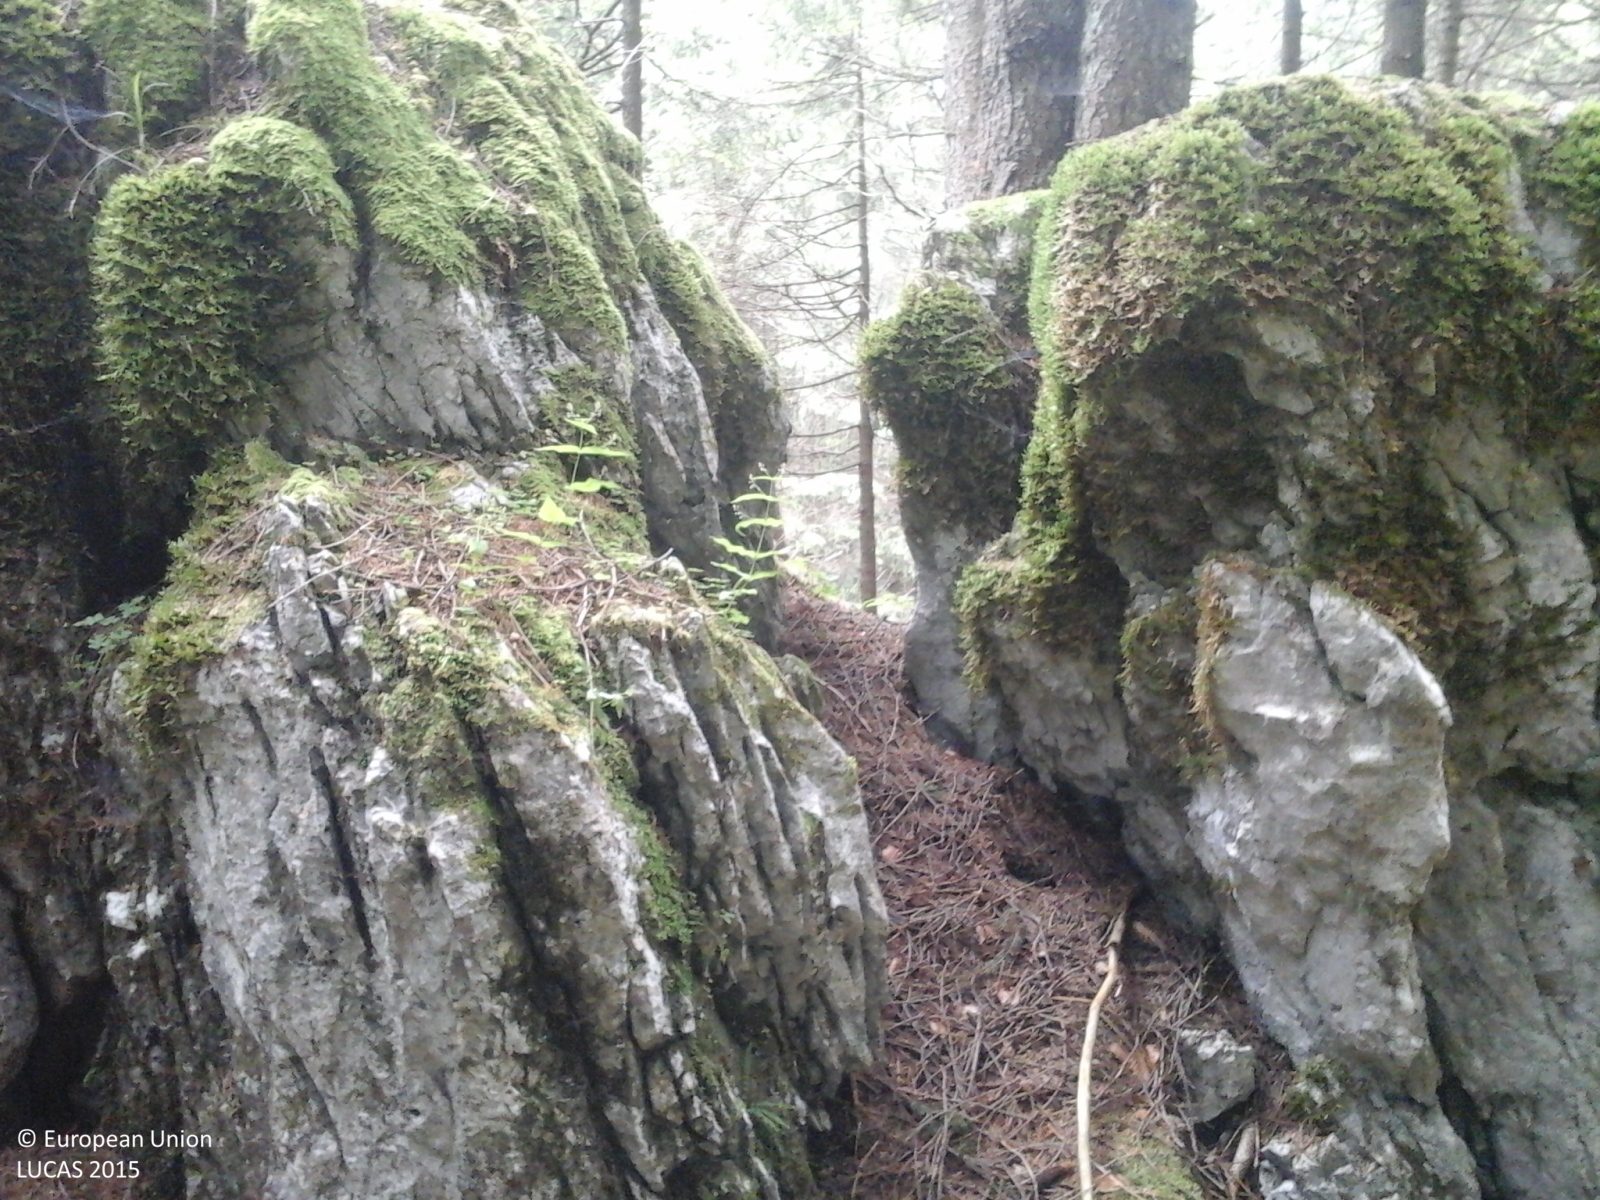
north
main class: Woodland
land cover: Spruce dominated mixed woodland
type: alpine coniferous forest
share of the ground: > 75 %
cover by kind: coniferous forest trees 75 %, broadleaved forest trees 25 %
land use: Forestry
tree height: > 5 m
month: June
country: IT
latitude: 45.8177
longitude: 11.5293
